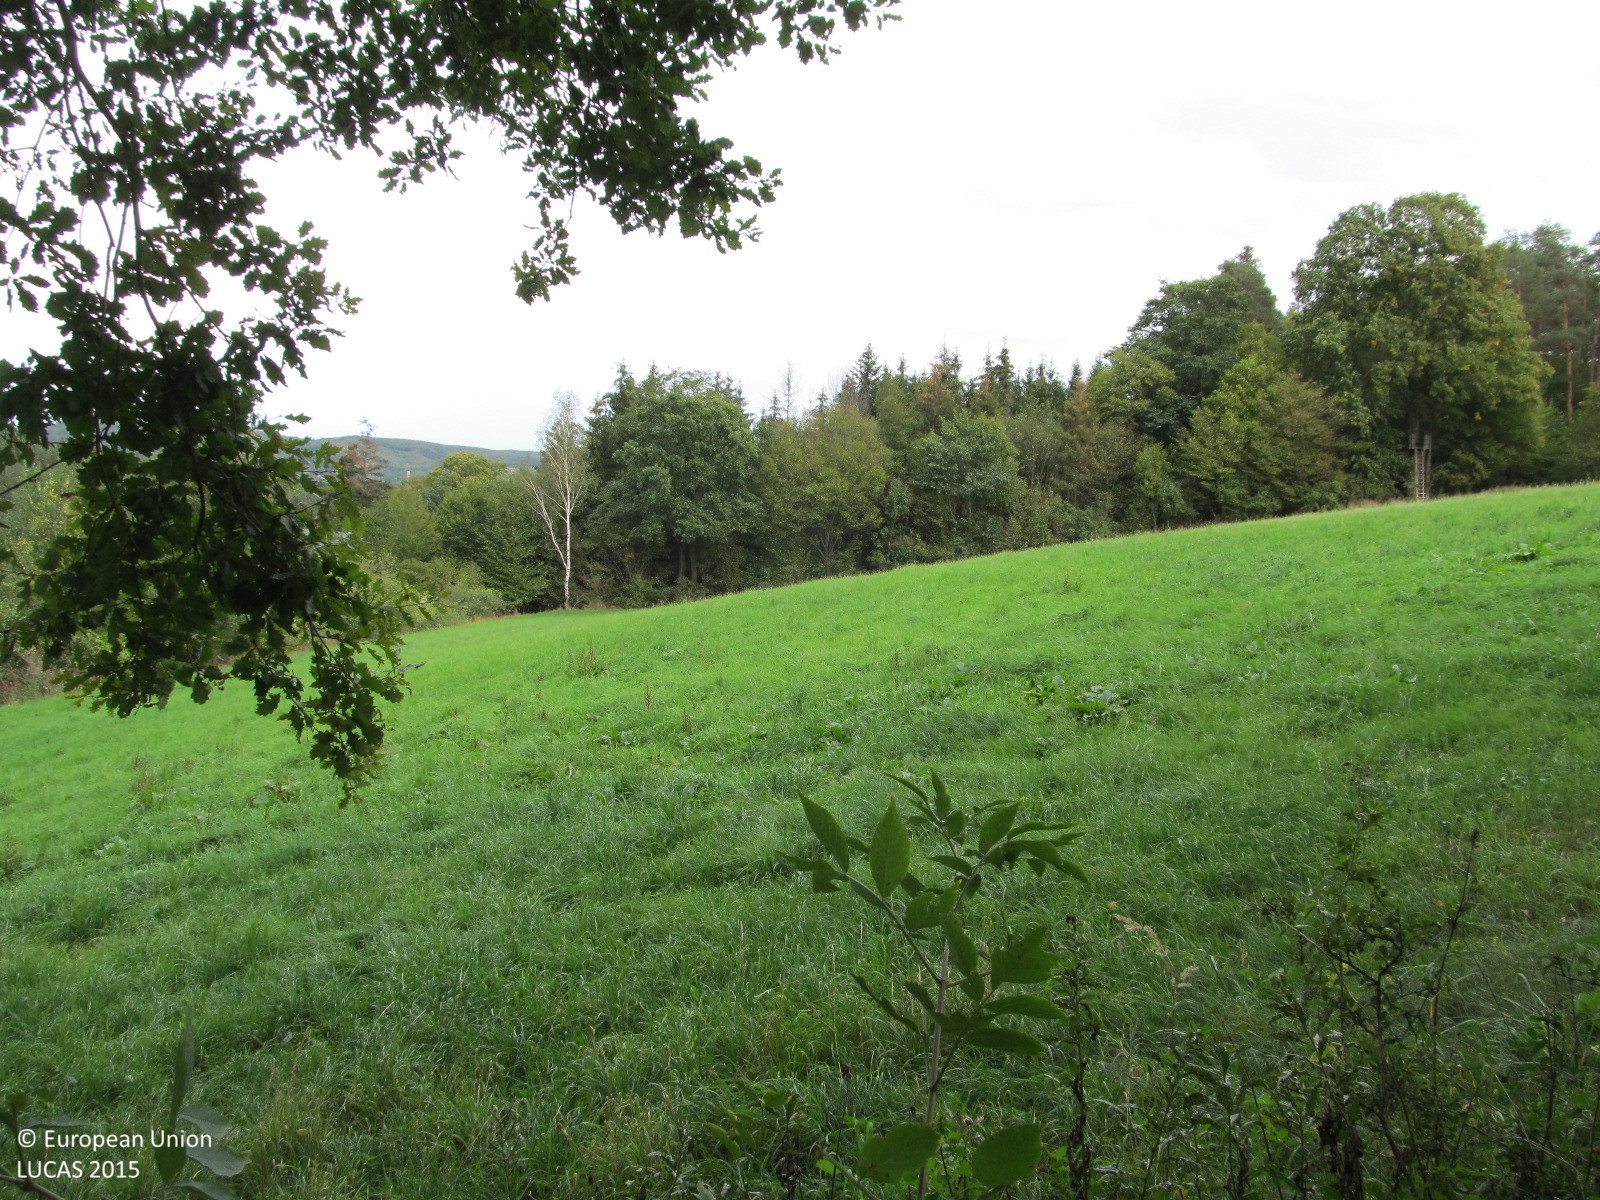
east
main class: Woodland
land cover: Spruce dominated coniferous woodland
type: hemiboreal forest and nemoral coniferous forest and mixed broadleaved-coniferous forest
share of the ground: > 75 %
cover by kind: coniferous forest trees 80 %, unconsolidated bare surface 20 %
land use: Forestry
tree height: > 5 m
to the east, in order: Spruce dominated coniferous woodland; Grassland without tree/shrub cover; Broadleaved woodland; Other mixed woodland; Broadleaved woodland; Tracks; Other mixed woodland; Tracks; Broadleaved woodland; Spruce dominated mixed woodland
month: September
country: AT
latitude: 48.6108
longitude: 15.4688
